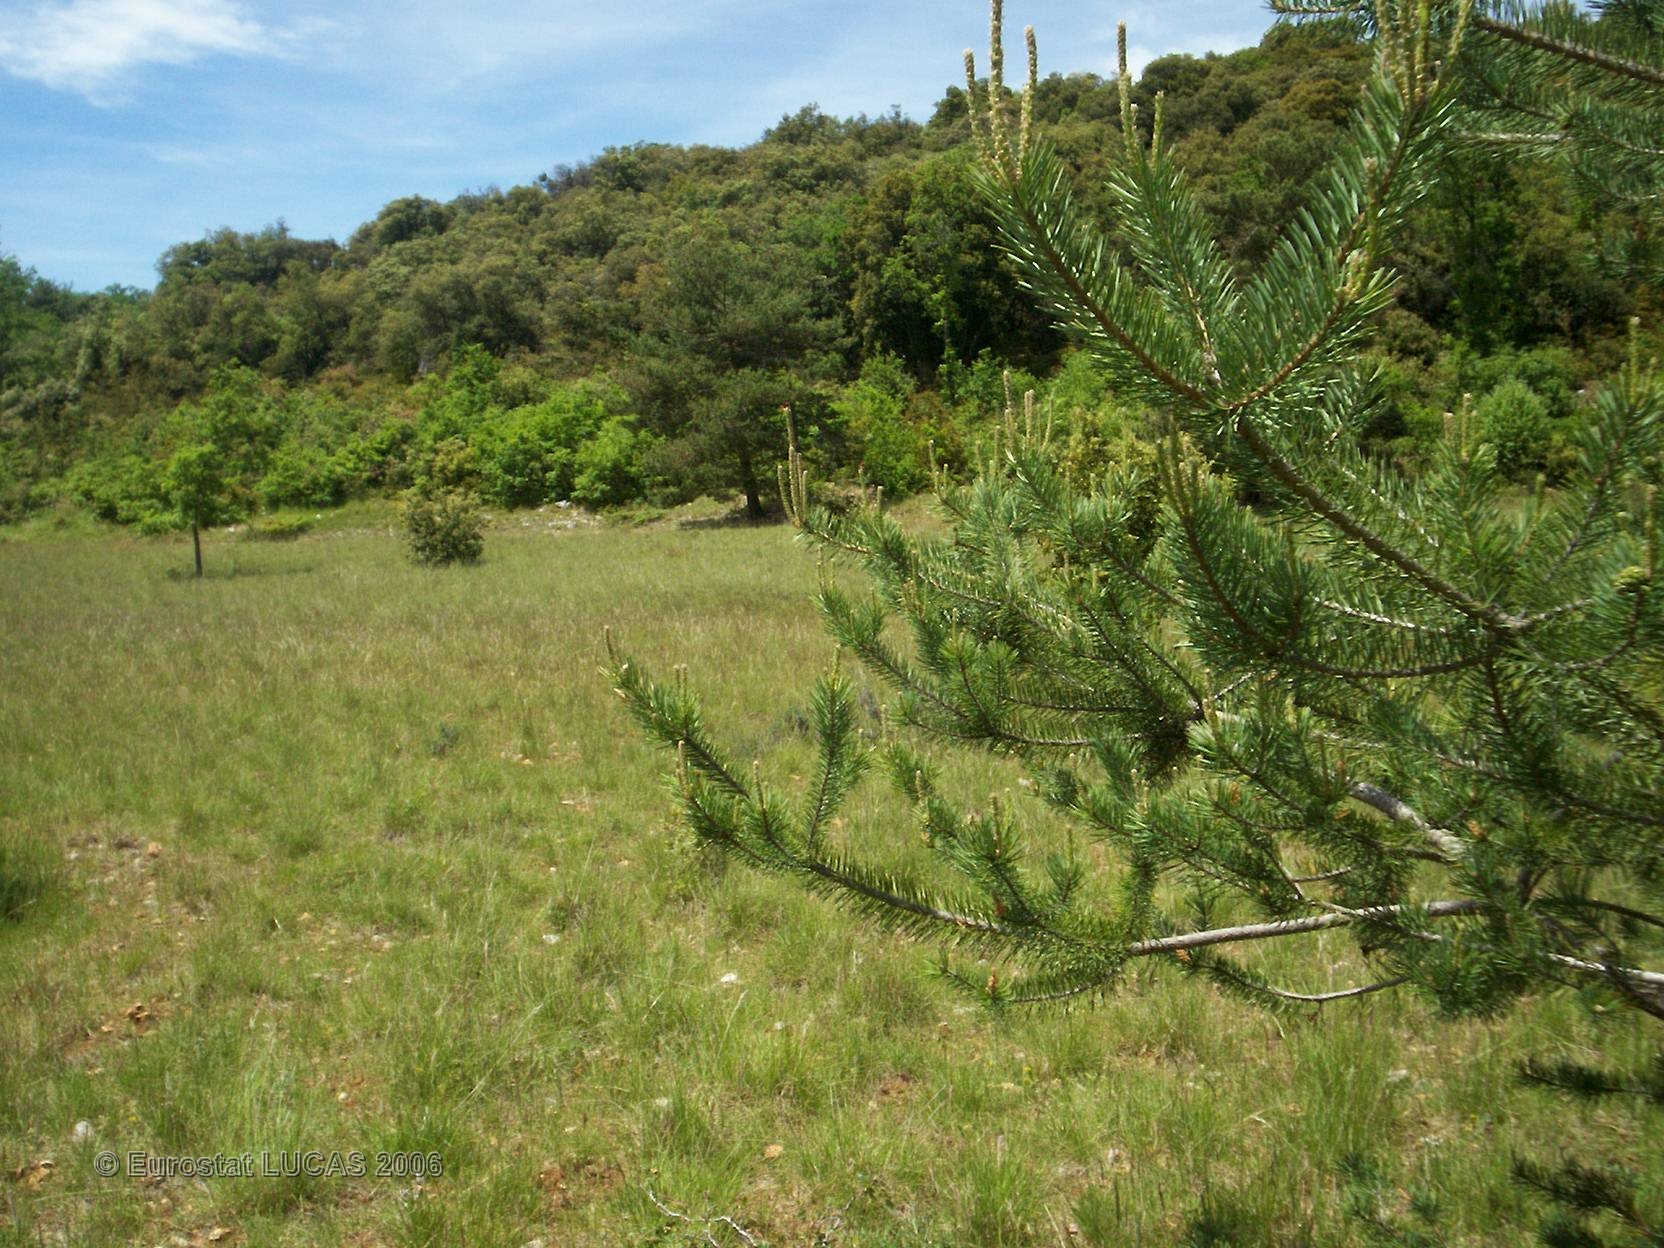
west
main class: Grassland
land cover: Grassland with sparse tree/shrub cover
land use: Agriculture (excluding fallow land and kitchen gardens)
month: May
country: FR
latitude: 44.0095
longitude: 5.3061
